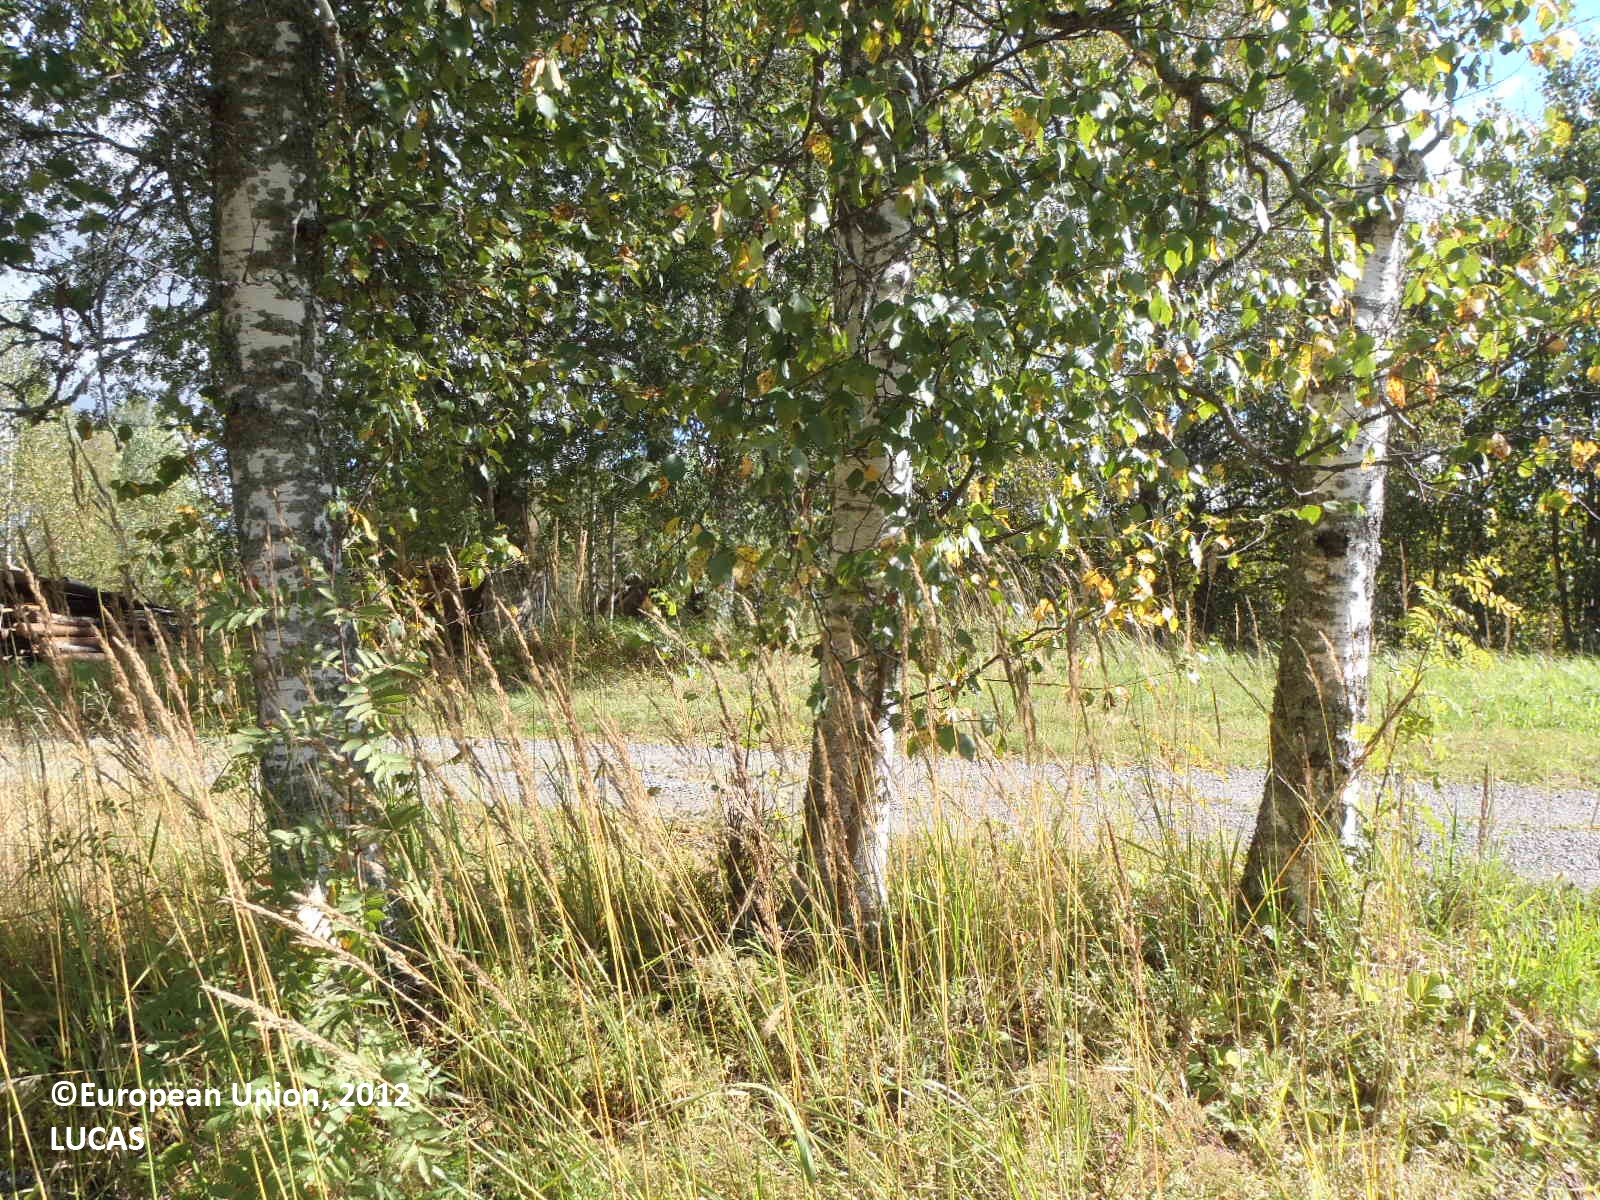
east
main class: Grassland
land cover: Grassland without tree/shrub cover
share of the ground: > 75 %
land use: Residential
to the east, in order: Grassland without tree/shrub cover; Ditches and canals; Broadleaved woodland; Paved roads, cycling and walking lanes; Grass margins; Broadleaved woodland; Grass margins; Electric lines; Ditches and canals; Grass margins; Other bare soil; Grassland without tree/shrub cover; Ditches and canals; Grassland without tree/shrub cover; Electric lines; Grassland without tree/shrub cover; Ditches and canals; Grassland with sparse tree/shrub cover; Ditches and canals; Broadleaved woodland; Grass margins; Tracks; Electric lines; Tracks; Grass margins; Broadleaved woodland
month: September
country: FI
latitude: 61.3591
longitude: 22.6913
